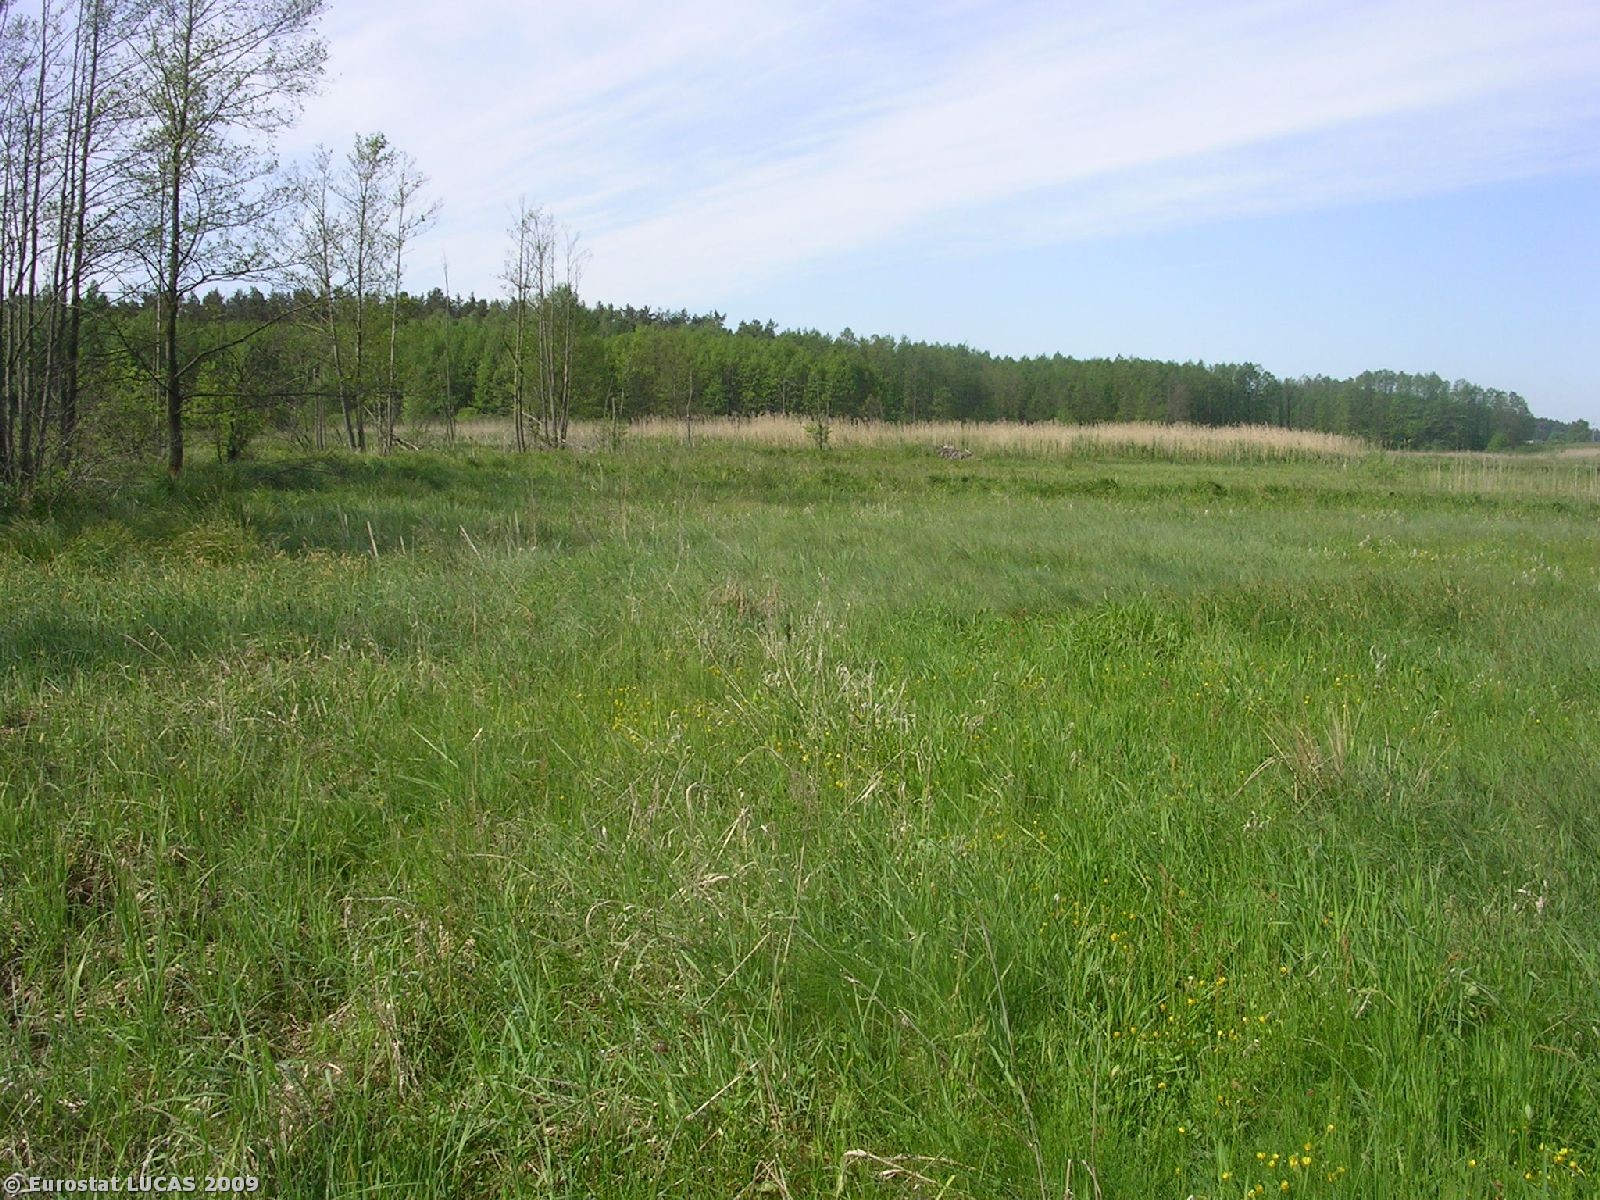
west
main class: Wetlands
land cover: Inland marshes
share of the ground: > 75 %
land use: Unused
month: May
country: PL
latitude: 53.2702
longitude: 23.2594
